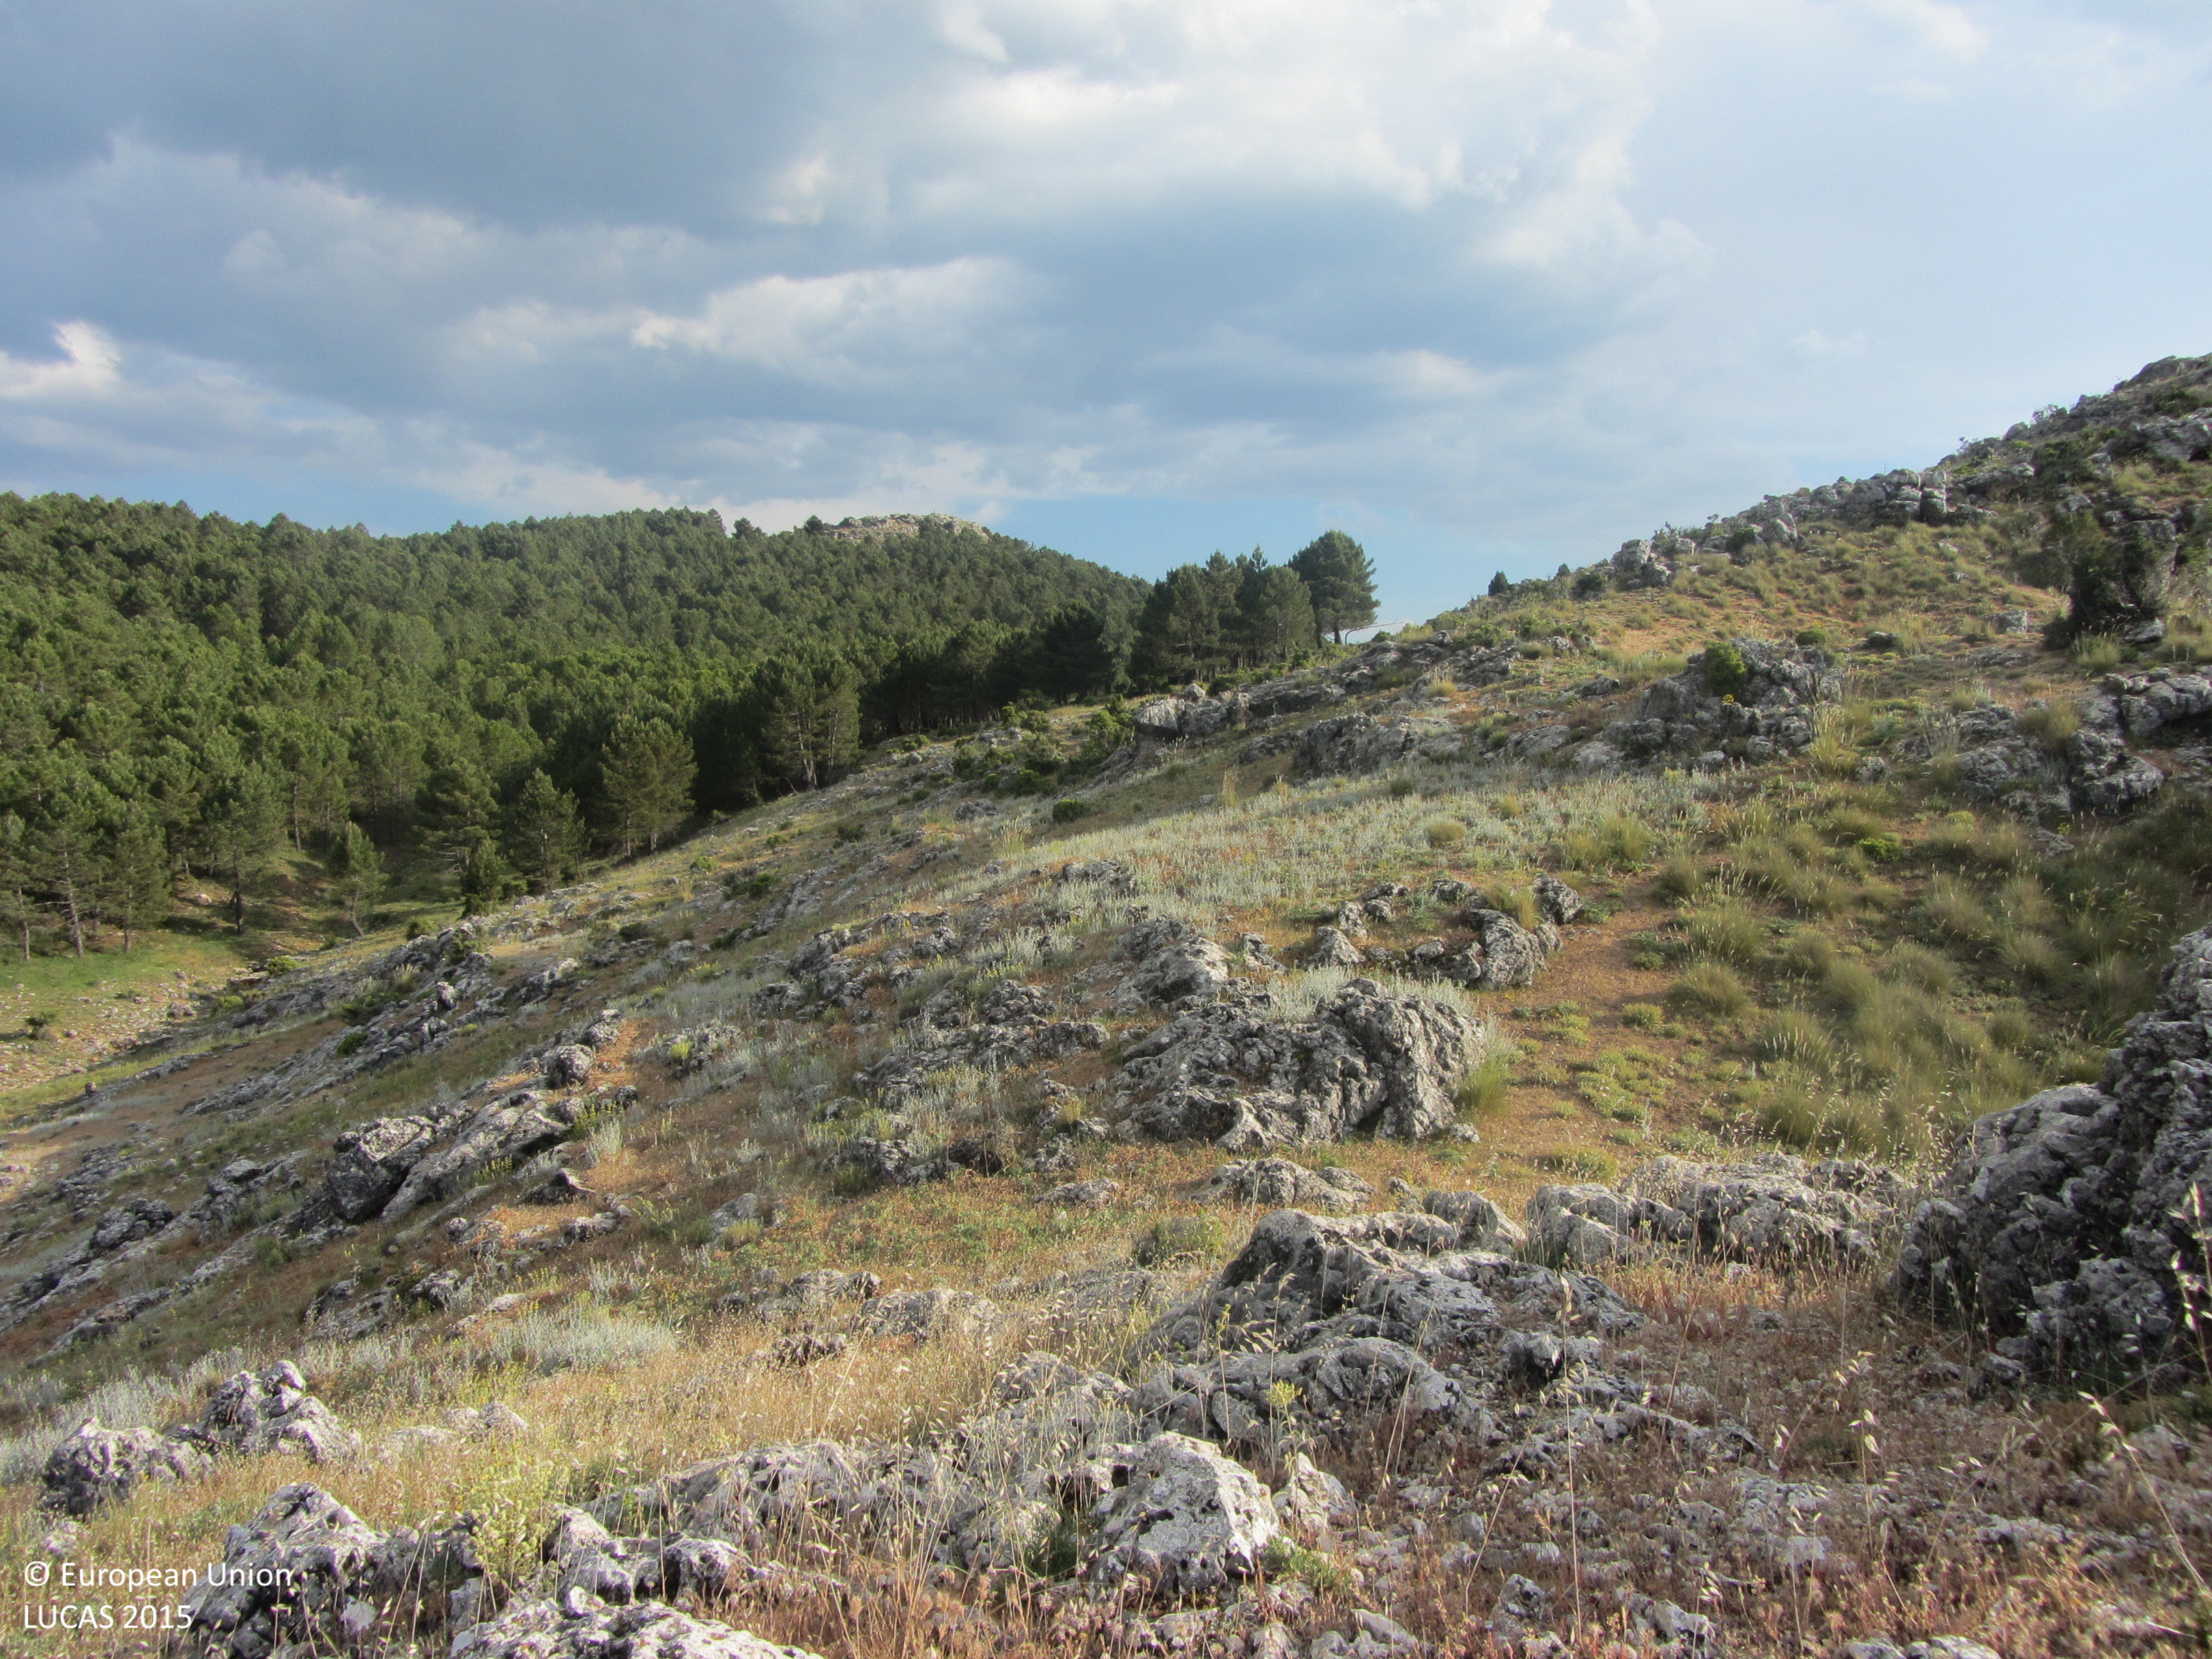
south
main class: Woodland
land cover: Pine dominated coniferous woodland
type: coniferous forest of the mediterranean region
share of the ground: 50 - 75 %
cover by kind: coniferous forest trees 70 %, herbaceous plants 30 %
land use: Semi-natural and natural areas not in use
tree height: > 5 m
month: May
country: ES
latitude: 38.1269
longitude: -2.9224
